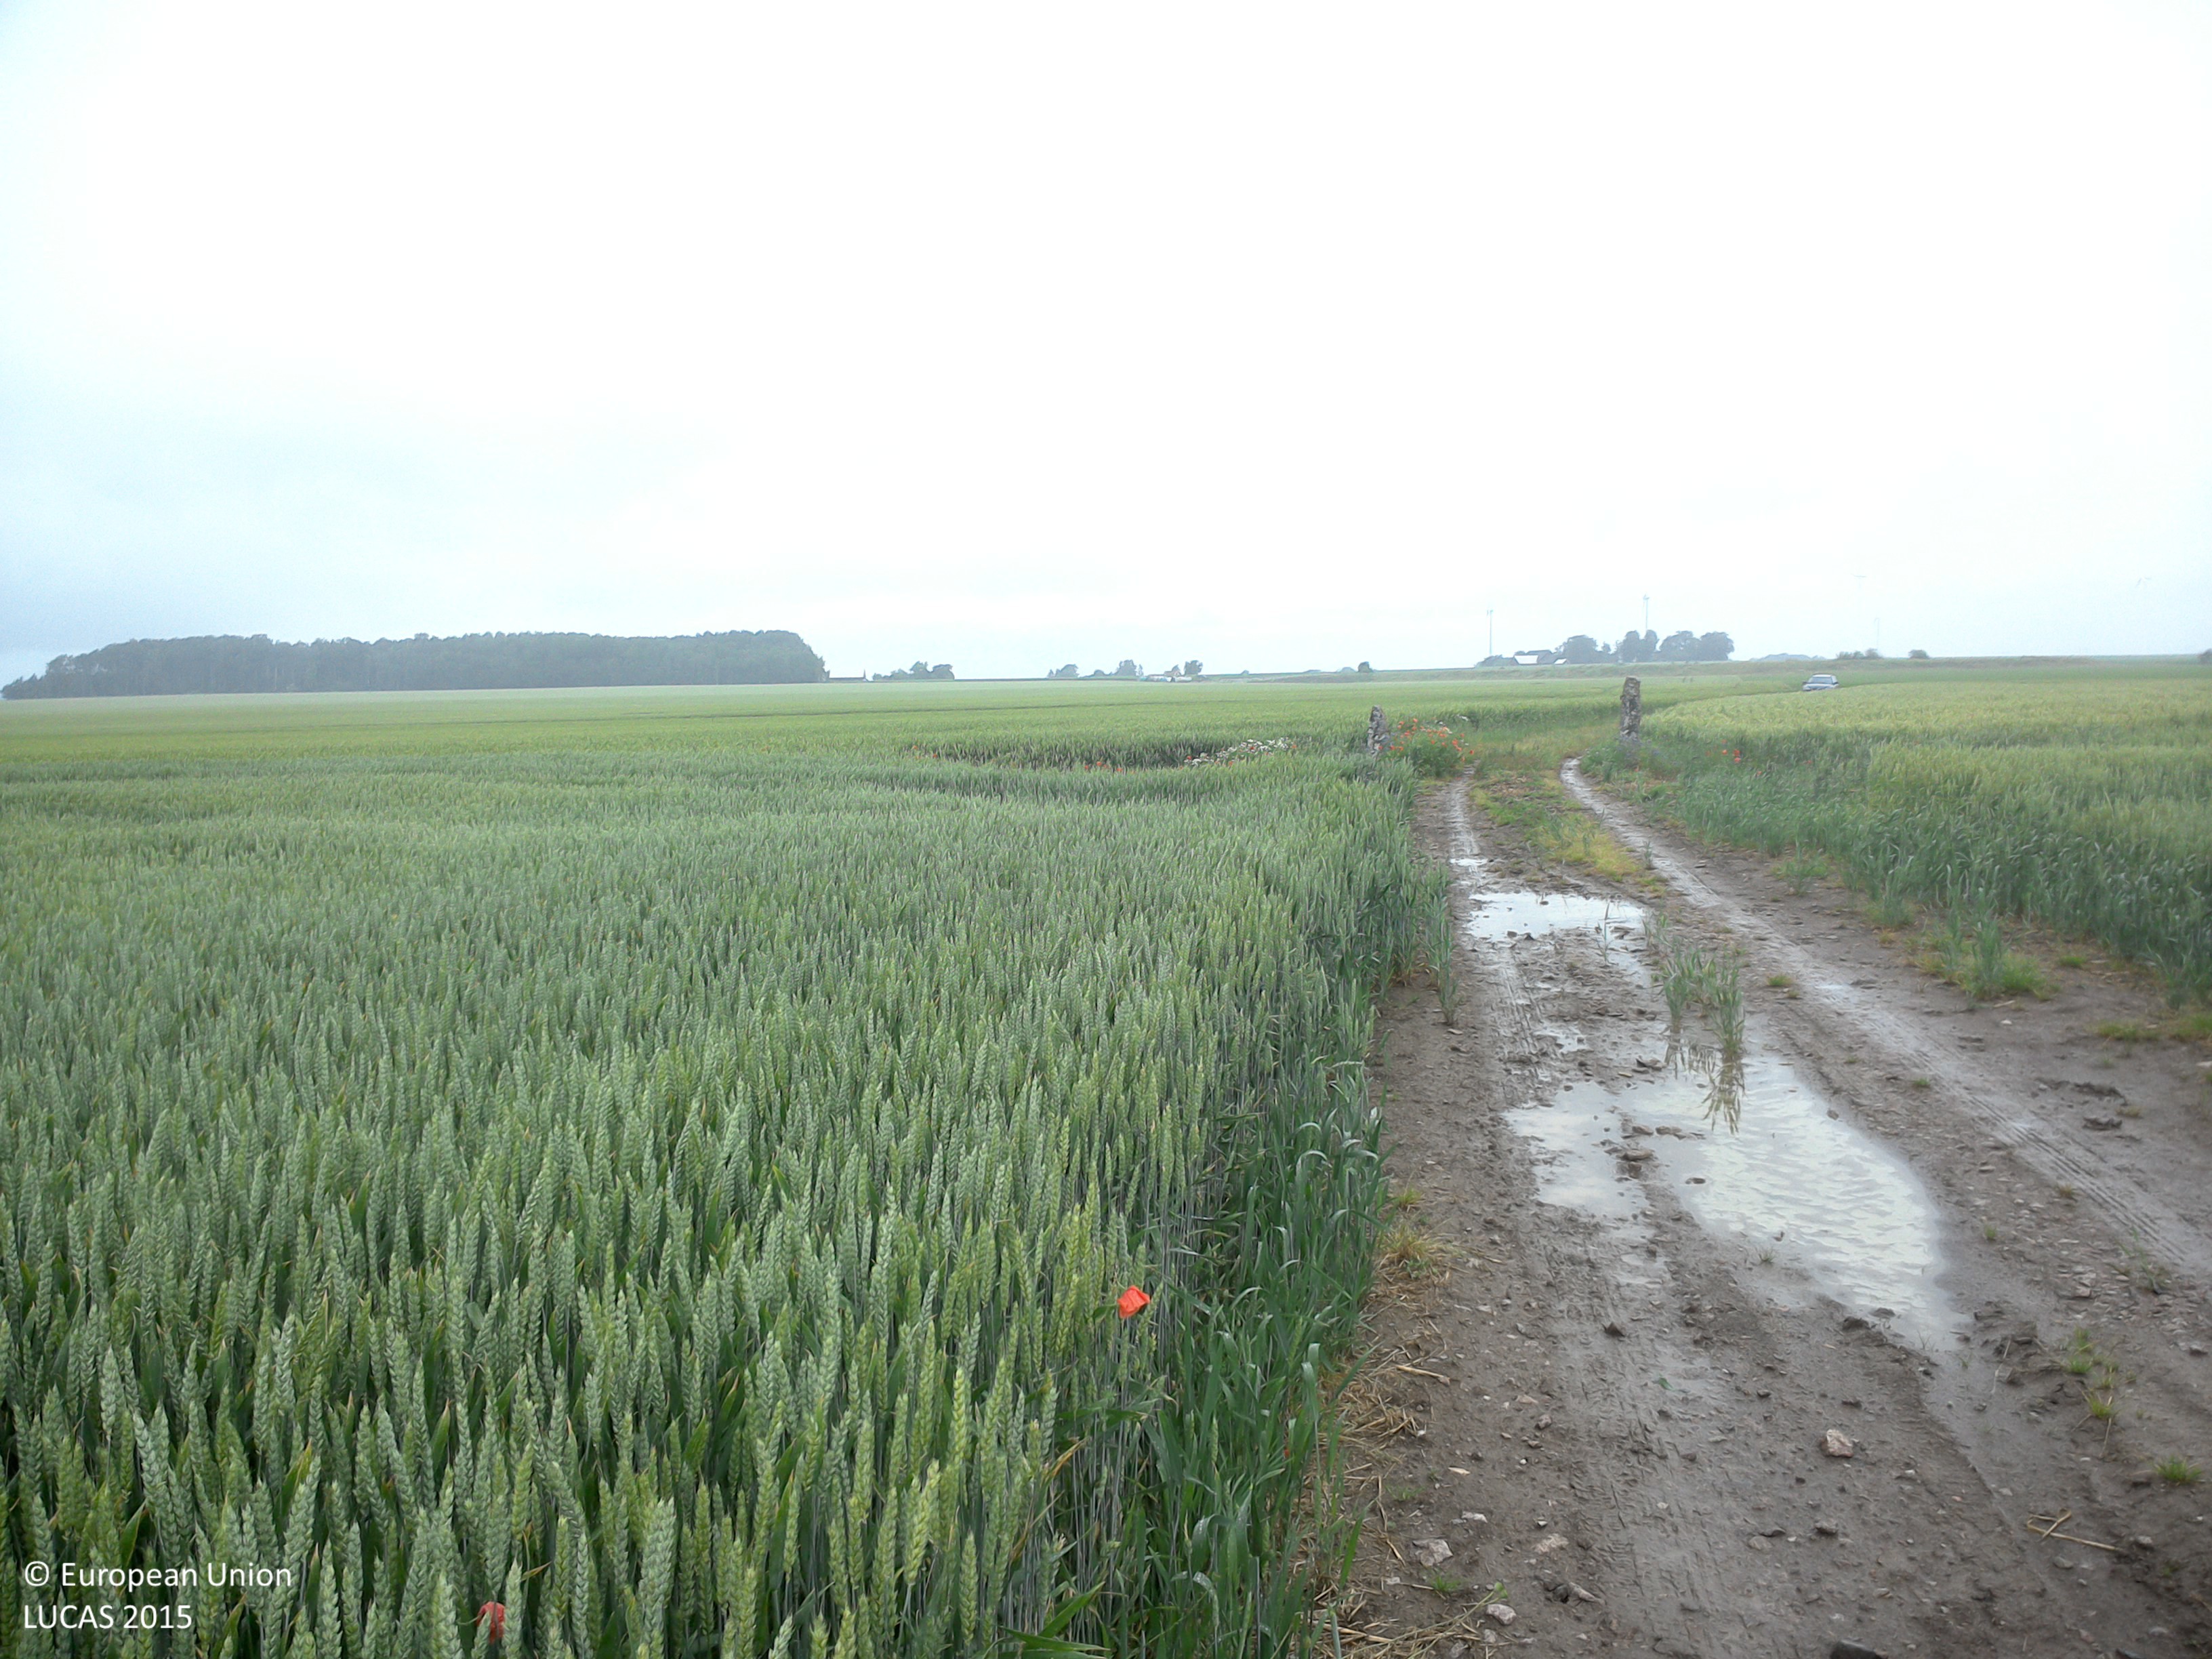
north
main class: Cropland
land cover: Common wheat
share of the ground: > 75 %
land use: Agriculture (excluding fallow land and kitchen gardens)
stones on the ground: < 10 %
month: July
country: SE
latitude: 58.3621
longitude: 14.9679
